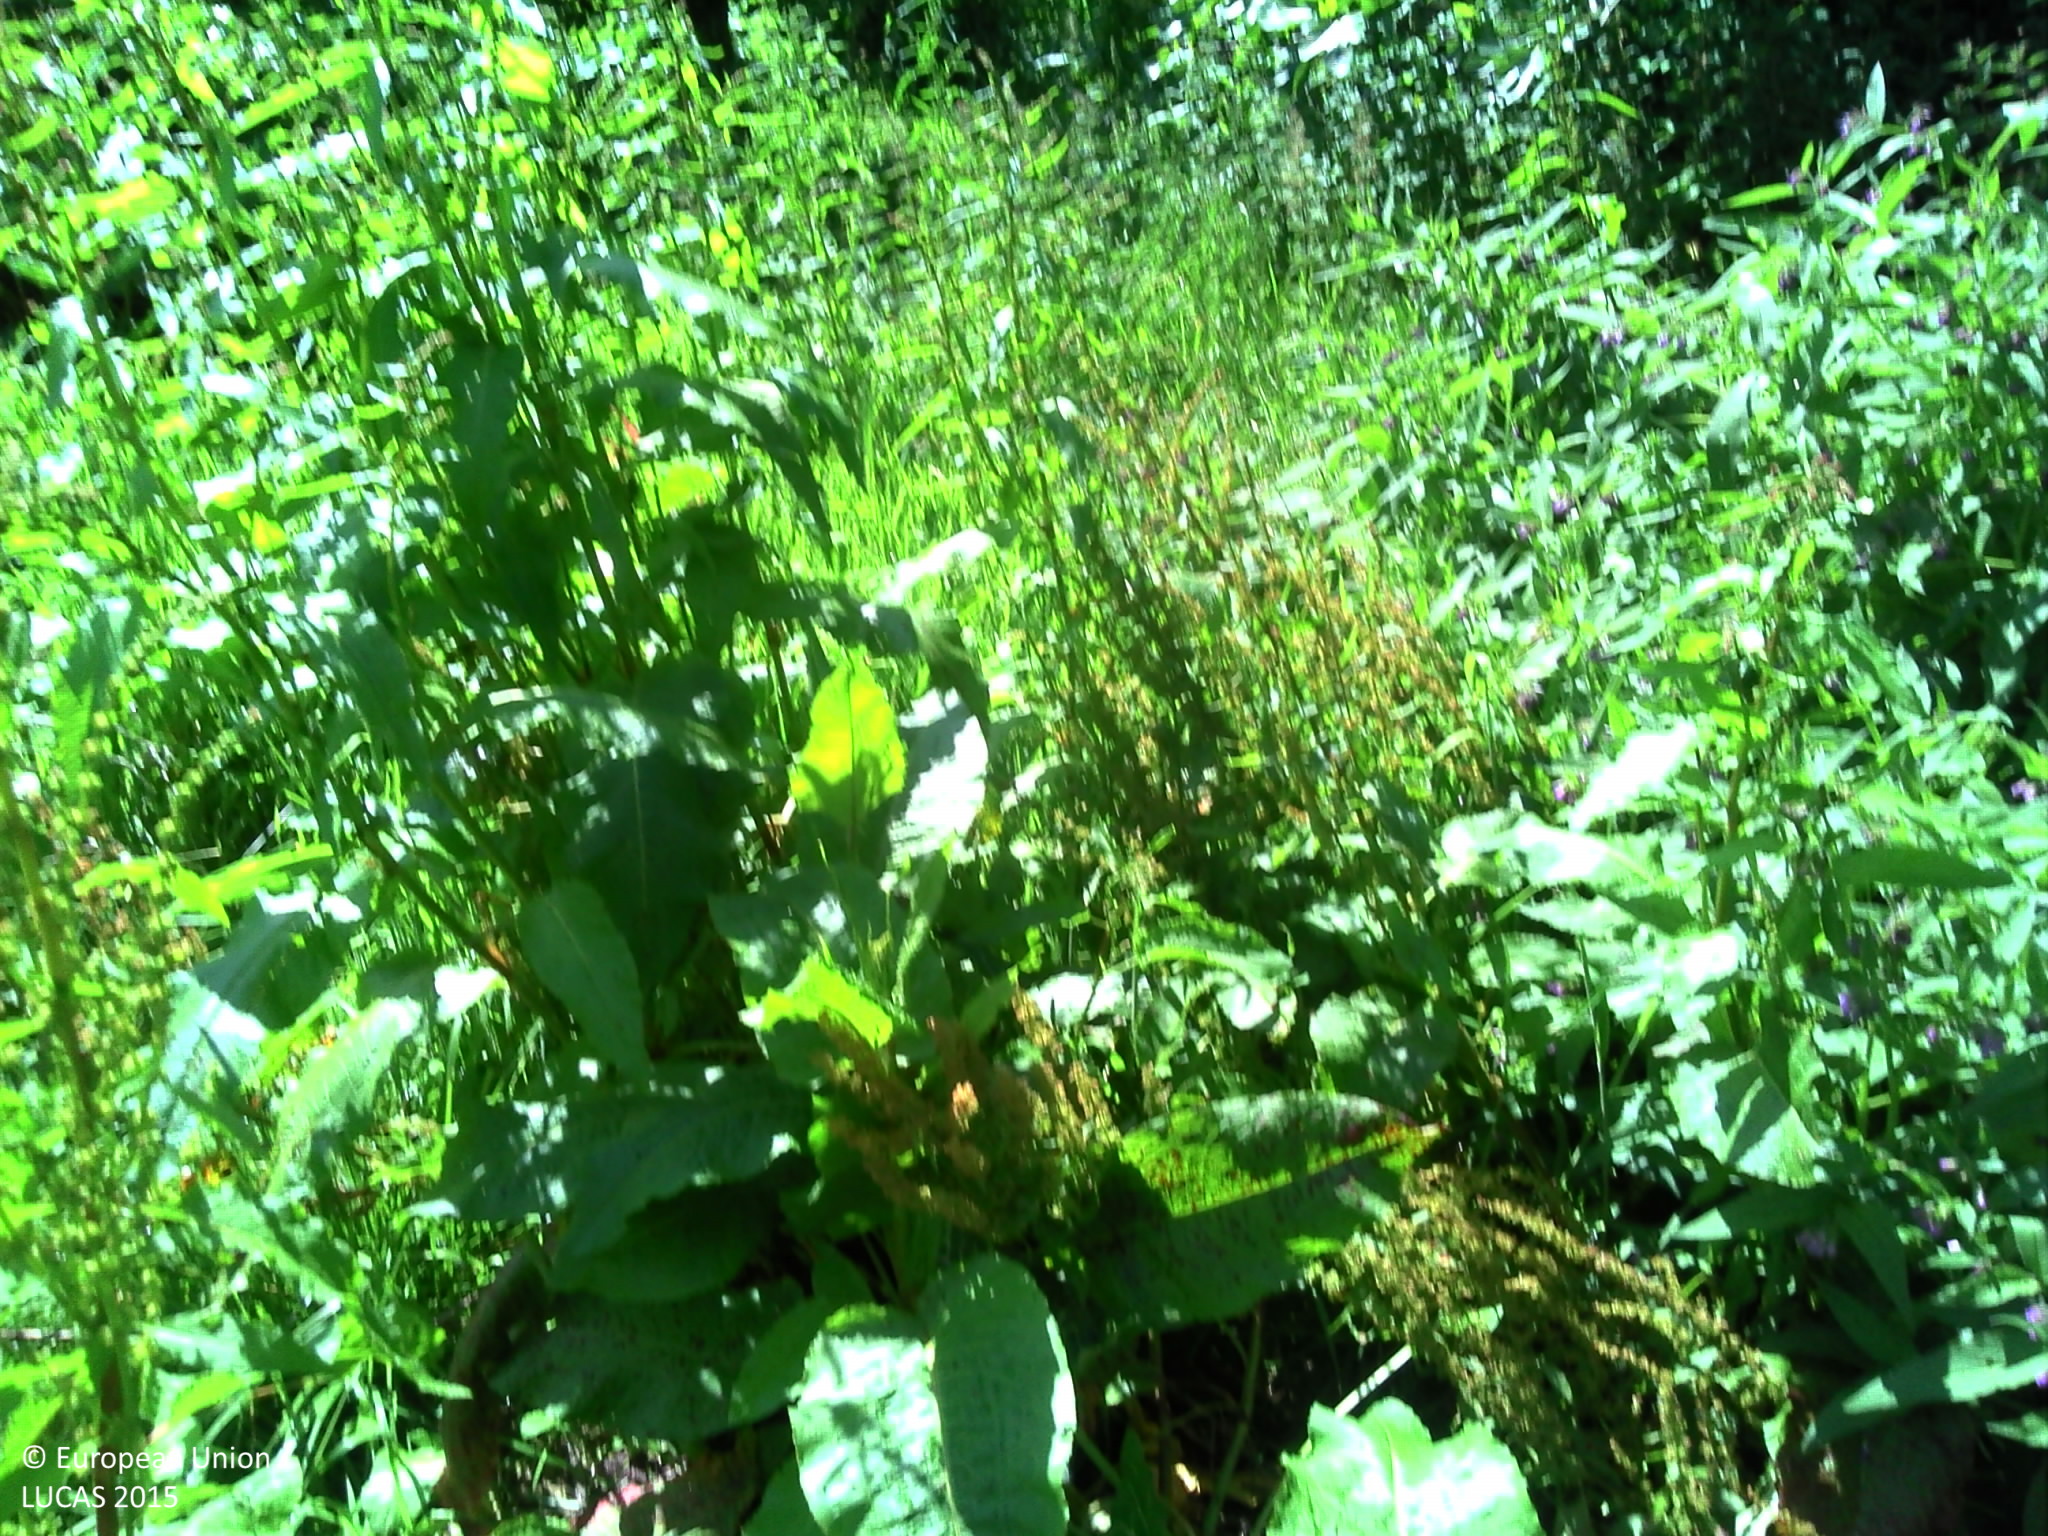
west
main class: Grassland
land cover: Spontaneously vegetated surfaces
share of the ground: > 75 %
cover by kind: herbaceous plants 100 %
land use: Residential
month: June
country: FR
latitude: 49.4896
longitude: -1.6897
